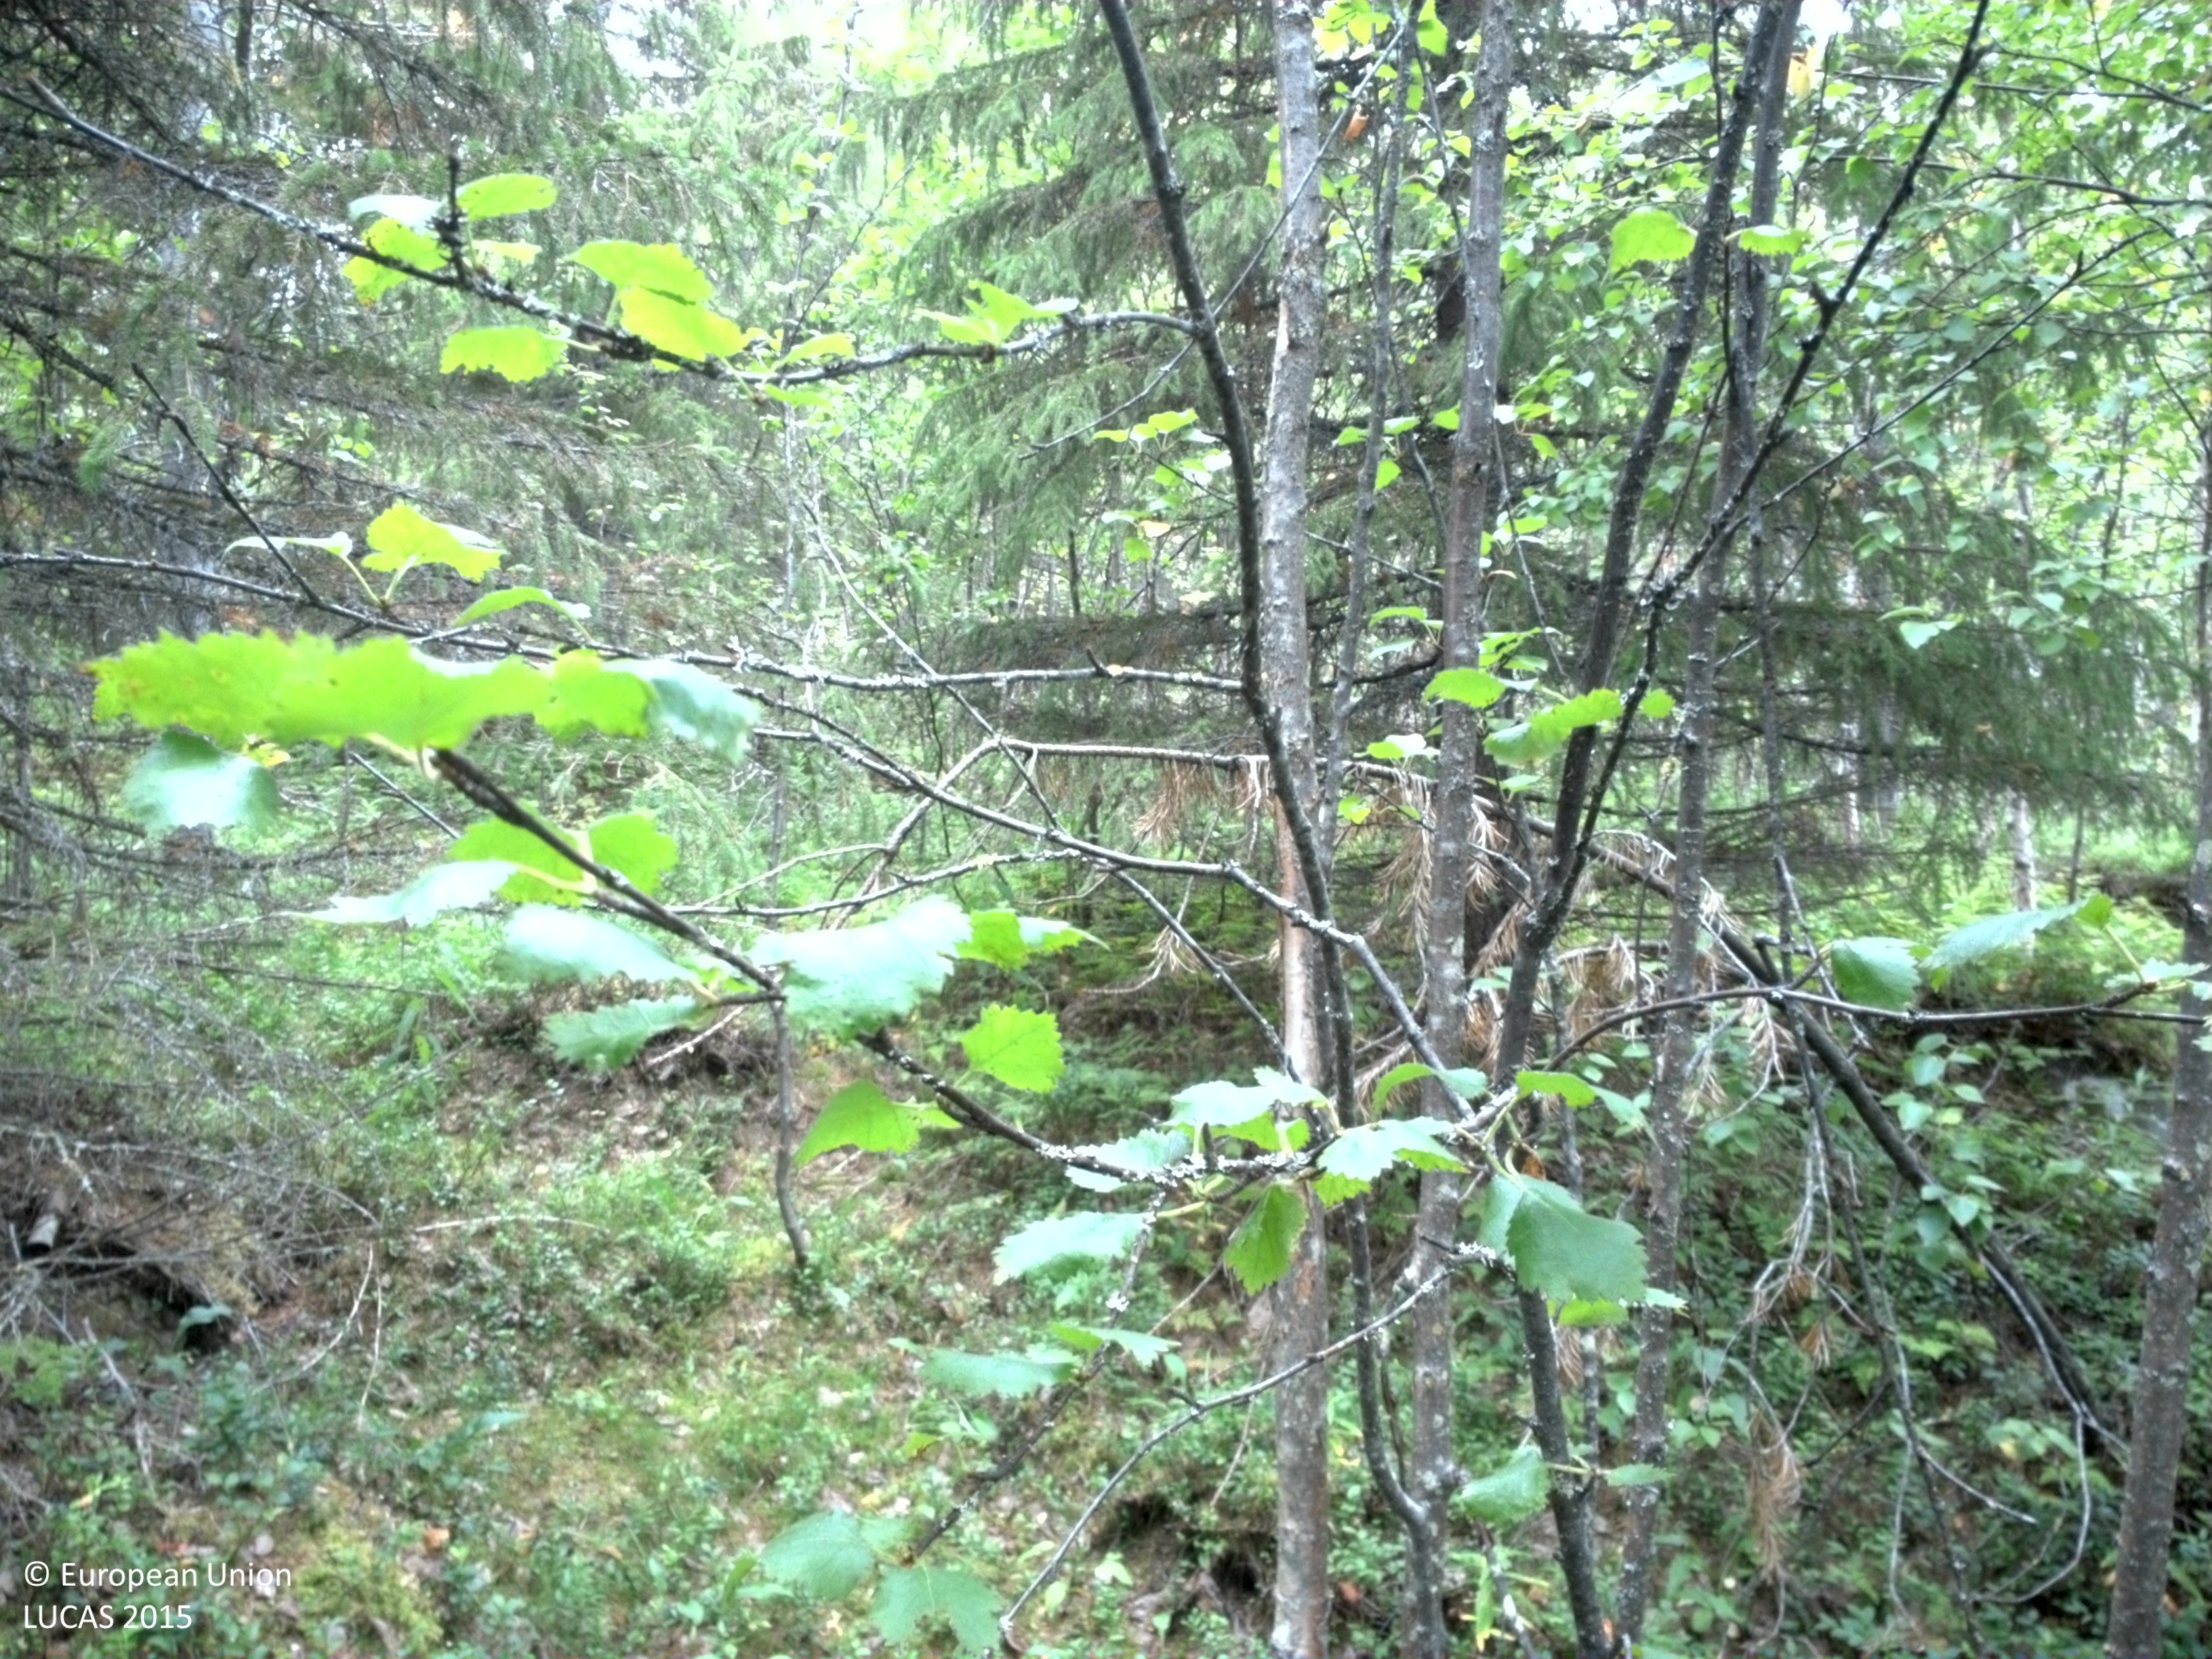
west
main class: Woodland
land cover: Other mixed woodland
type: exotic forest
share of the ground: 50 - 75 %
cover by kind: coniferous forest trees 30 %, broadleaved forest trees 30 %, shrubs 25 %, herbaceous plants 15 %
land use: Forestry
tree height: > 5 m
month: August
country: SE
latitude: 64.8356
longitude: 16.7312
